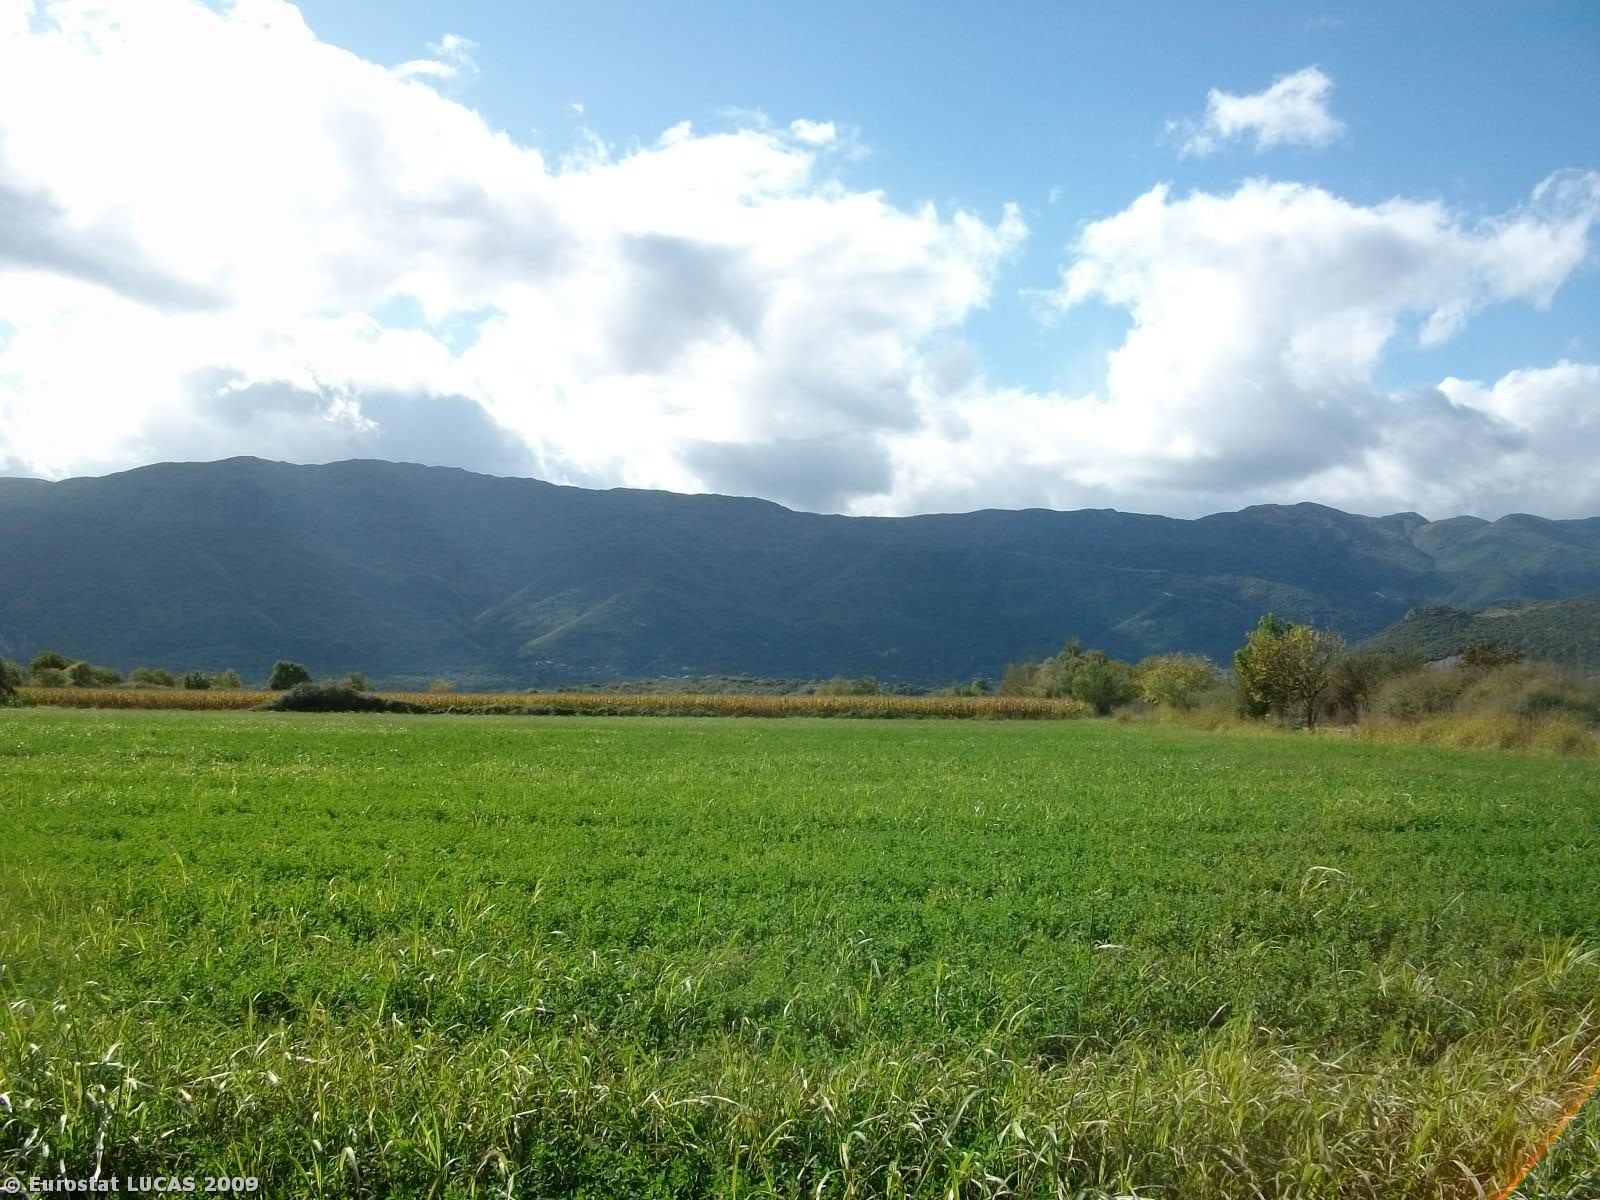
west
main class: Cropland
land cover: Clovers
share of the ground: > 75 %
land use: Agriculture (excluding fallow land and kitchen gardens)
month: October
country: GR
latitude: 39.8193
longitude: 20.5981
